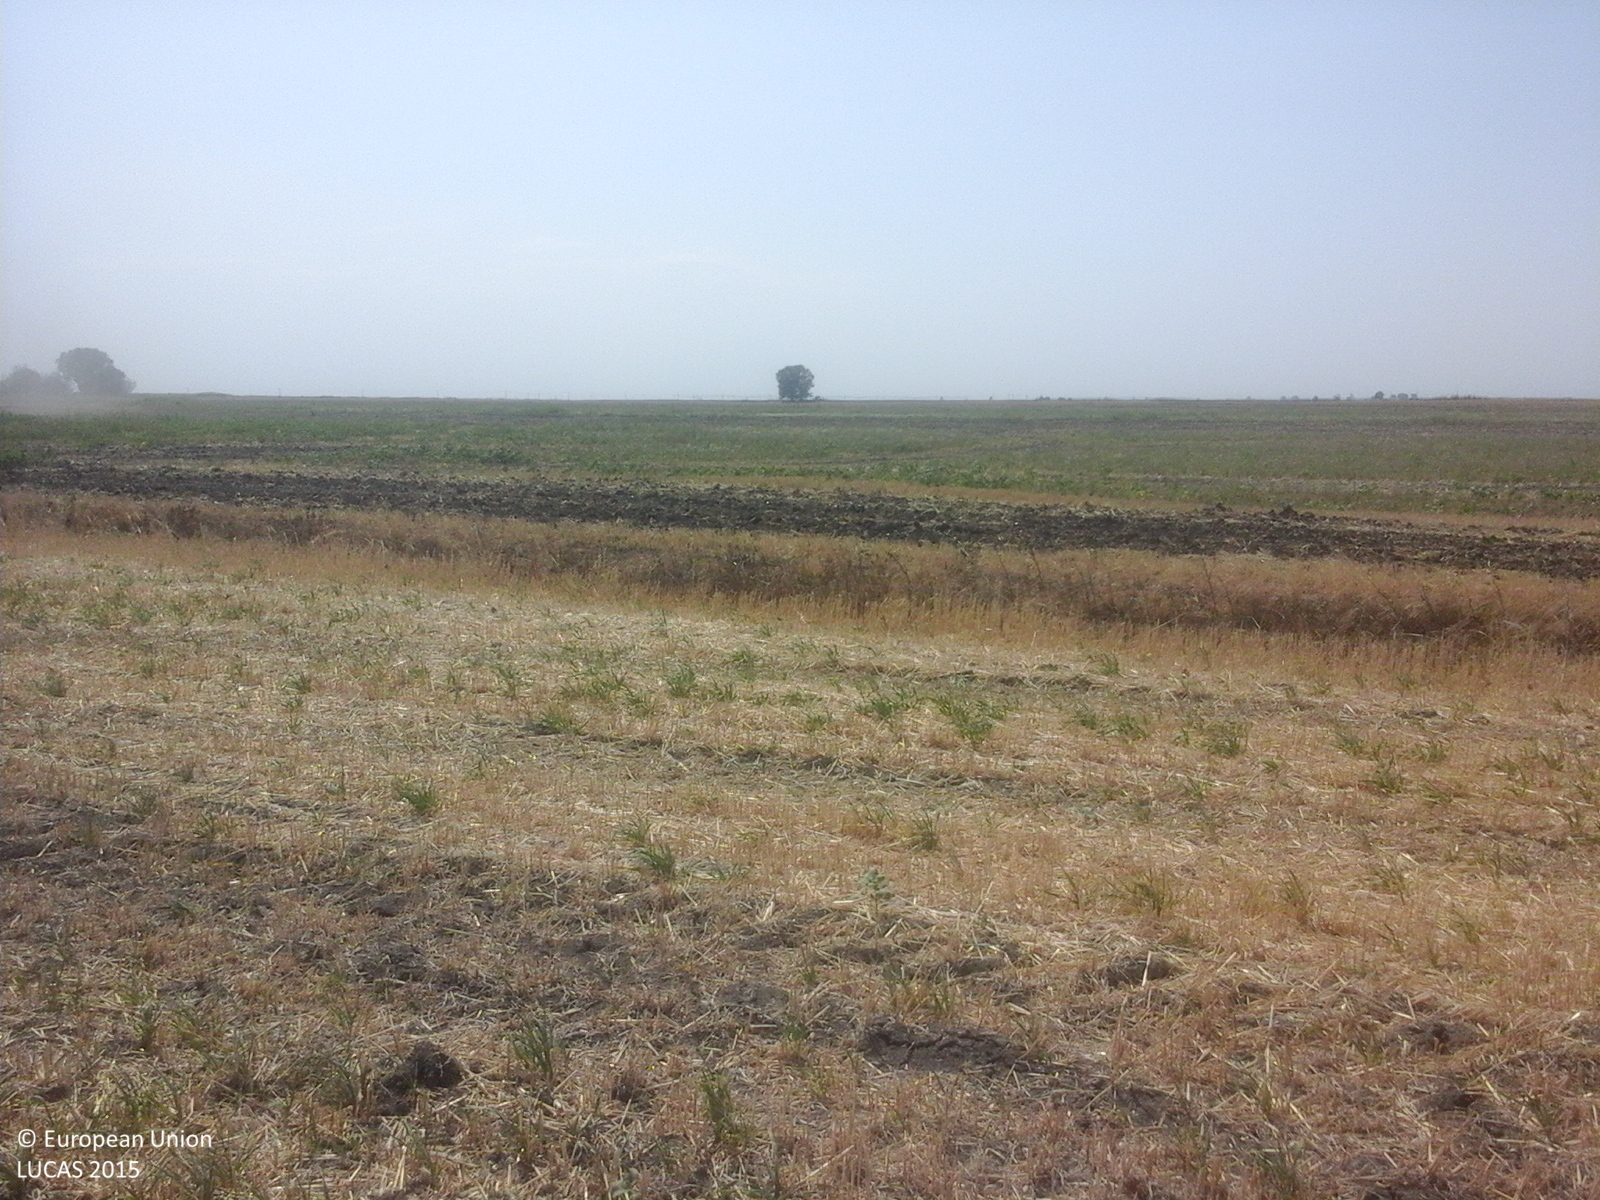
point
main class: Cropland
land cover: Common wheat
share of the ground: 50 - 75 %
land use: Agriculture (excluding fallow land and kitchen gardens)
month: August
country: RO
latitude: 45.1386
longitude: 28.1116
